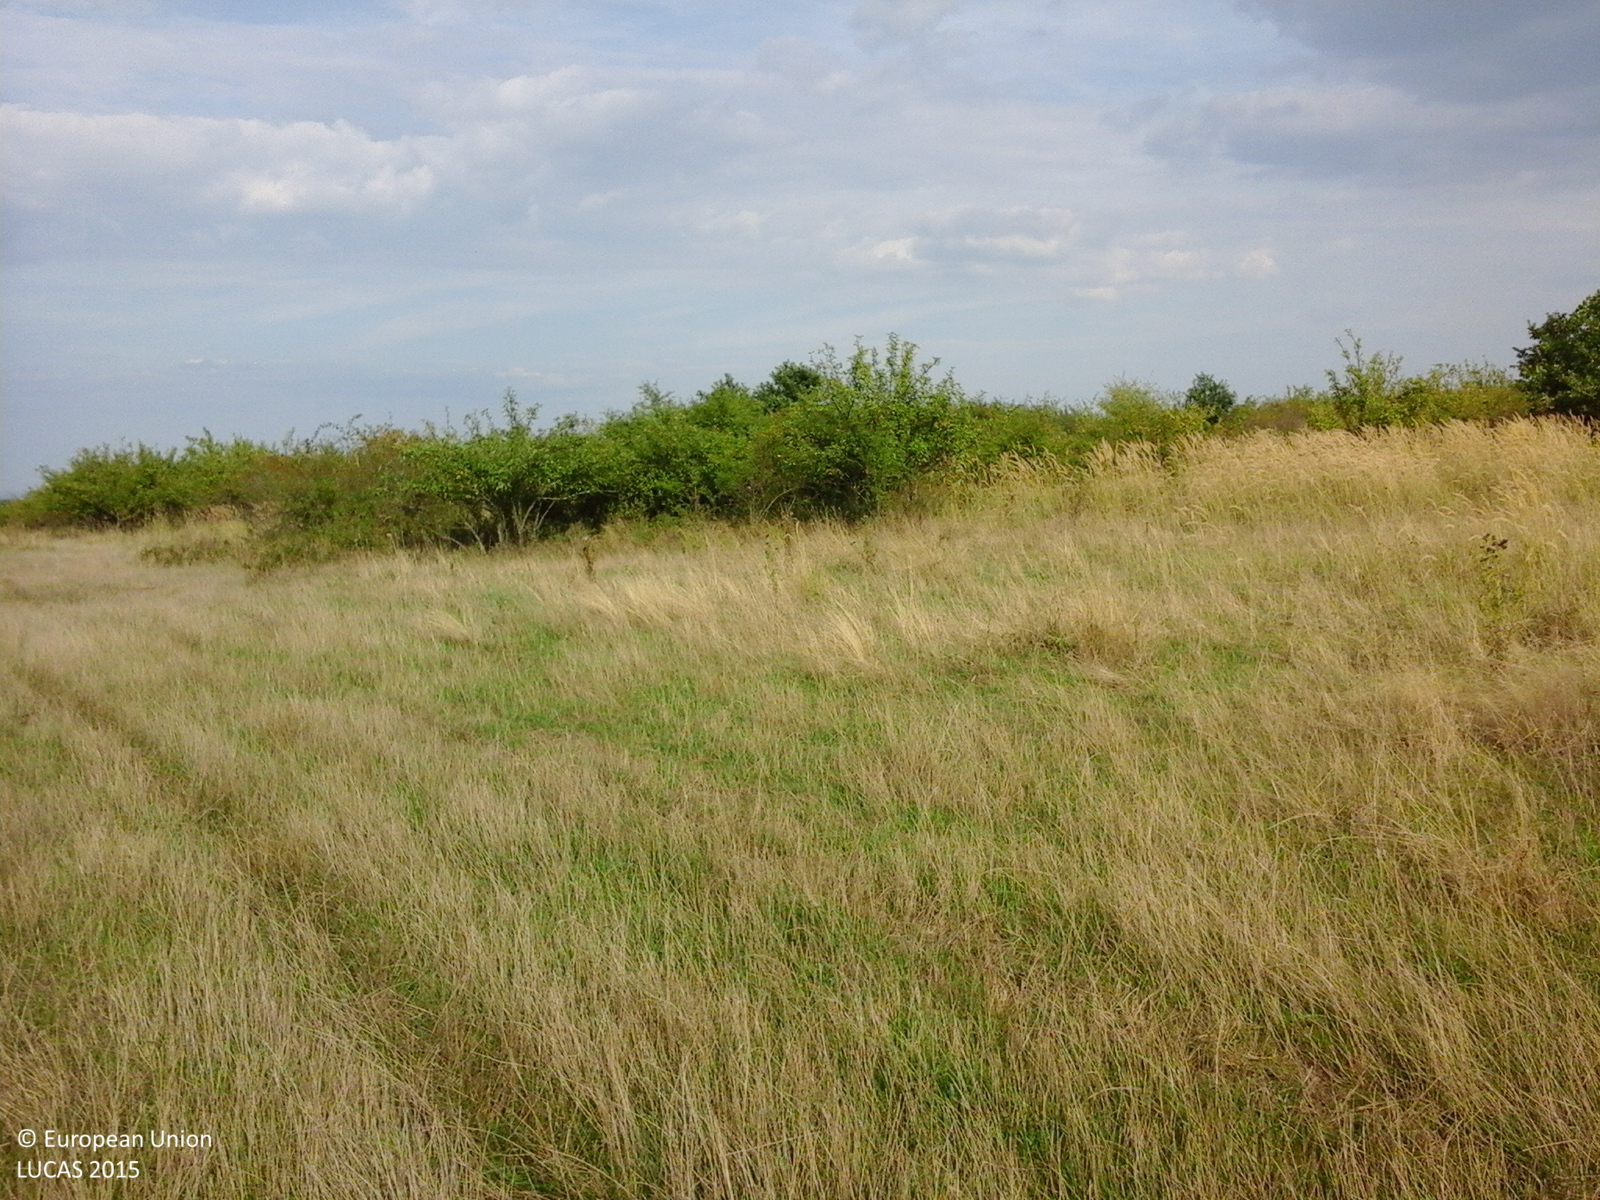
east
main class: Cropland
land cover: Apple fruit
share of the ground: > 75 %
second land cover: Grassland without tree/shrub cover
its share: > 75 %
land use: Agriculture (excluding fallow land and kitchen gardens)
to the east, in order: Apple fruit; Grassland without tree/shrub cover; Grass margins; Tracks; Grass margins; Shrubland without tree cover; Grassland without tree/shrub cover; Tracks; Grassland without tree/shrub cover
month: August
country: RO
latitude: 46.0570
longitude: 21.6576
